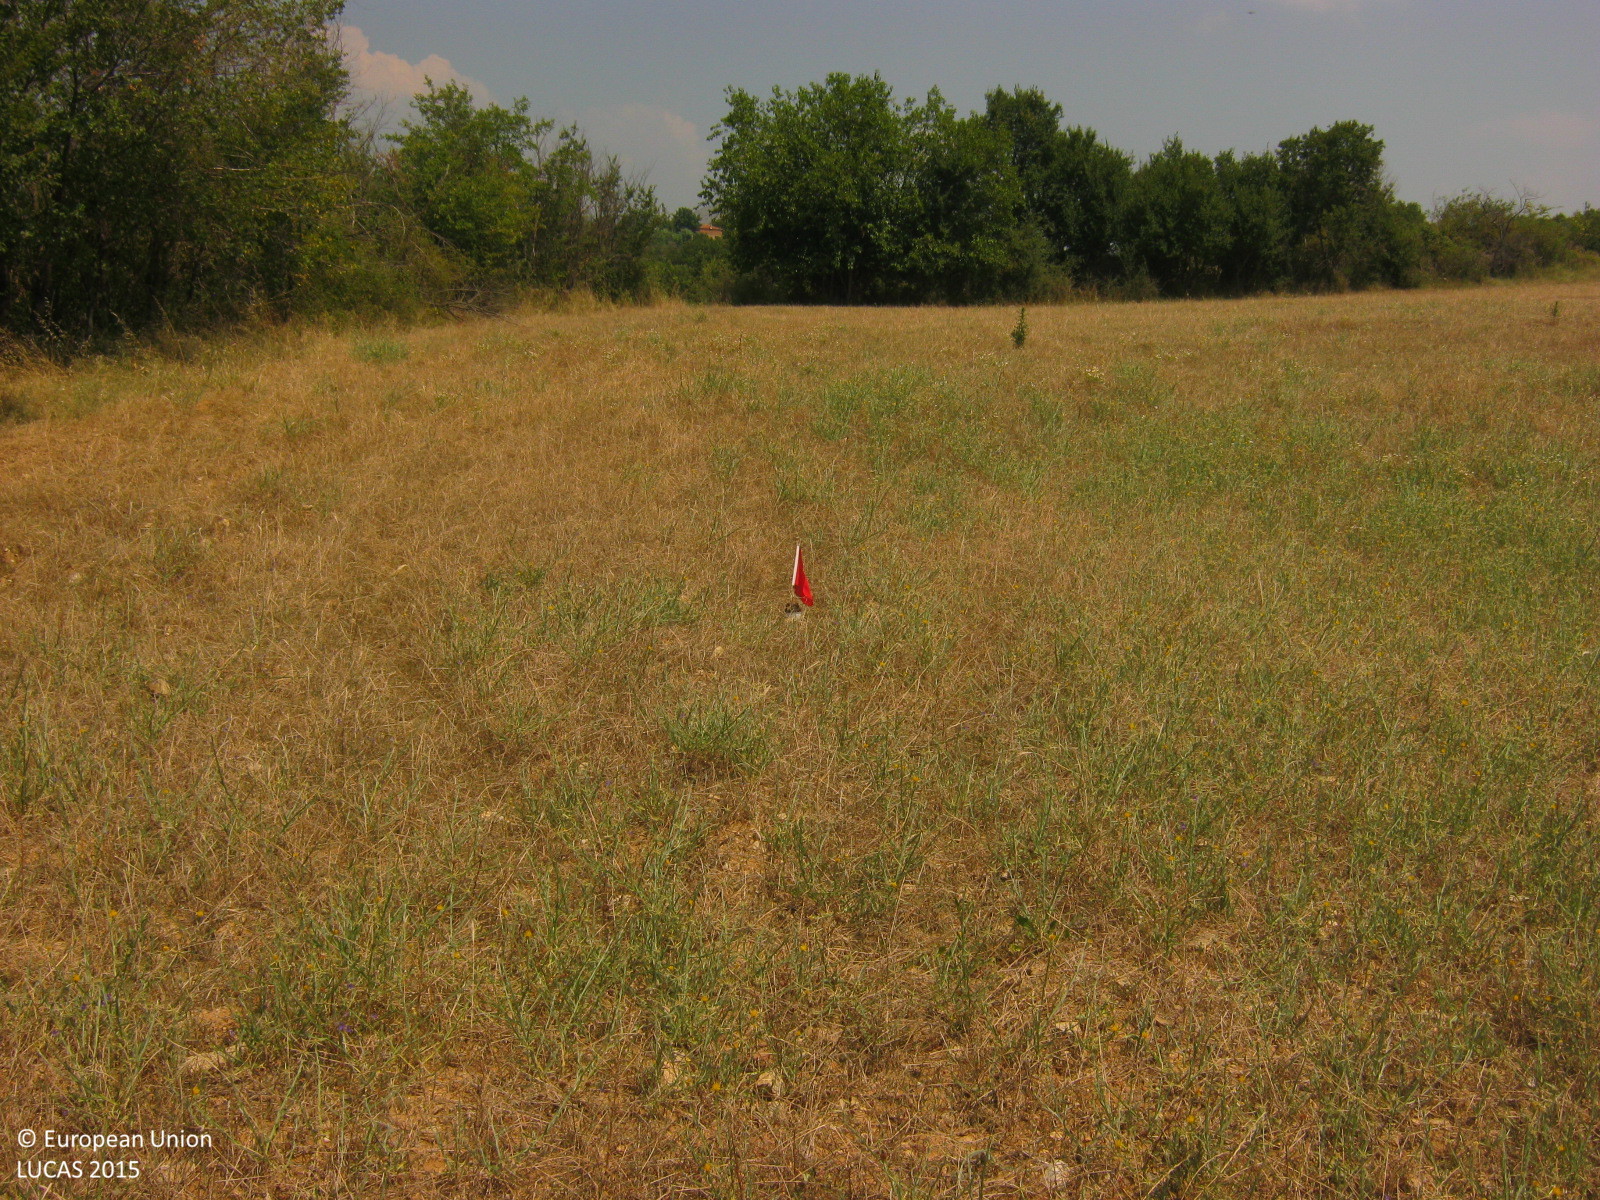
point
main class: Grassland
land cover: Spontaneously vegetated surfaces
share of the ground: > 75 %
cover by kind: herbaceous plants 95 %, unconsolidated bare surface 5 %
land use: Fallow land
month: July
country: GR
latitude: 41.1829
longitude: 24.3750
